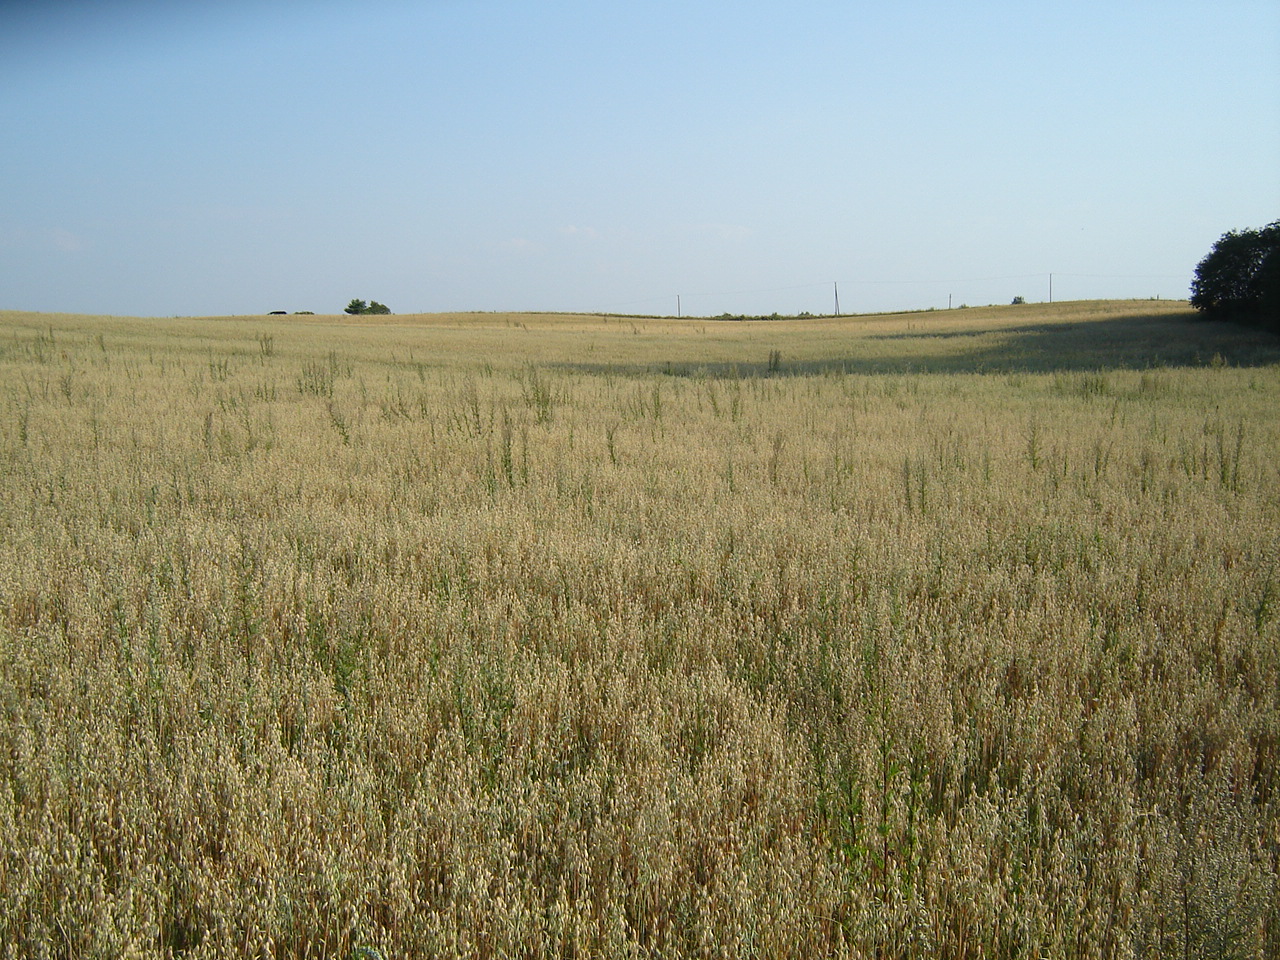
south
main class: Cropland
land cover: Oats
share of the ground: > 75 %
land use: Agriculture (excluding fallow land and kitchen gardens)
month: August
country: LT
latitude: 55.1977
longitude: 25.3771
